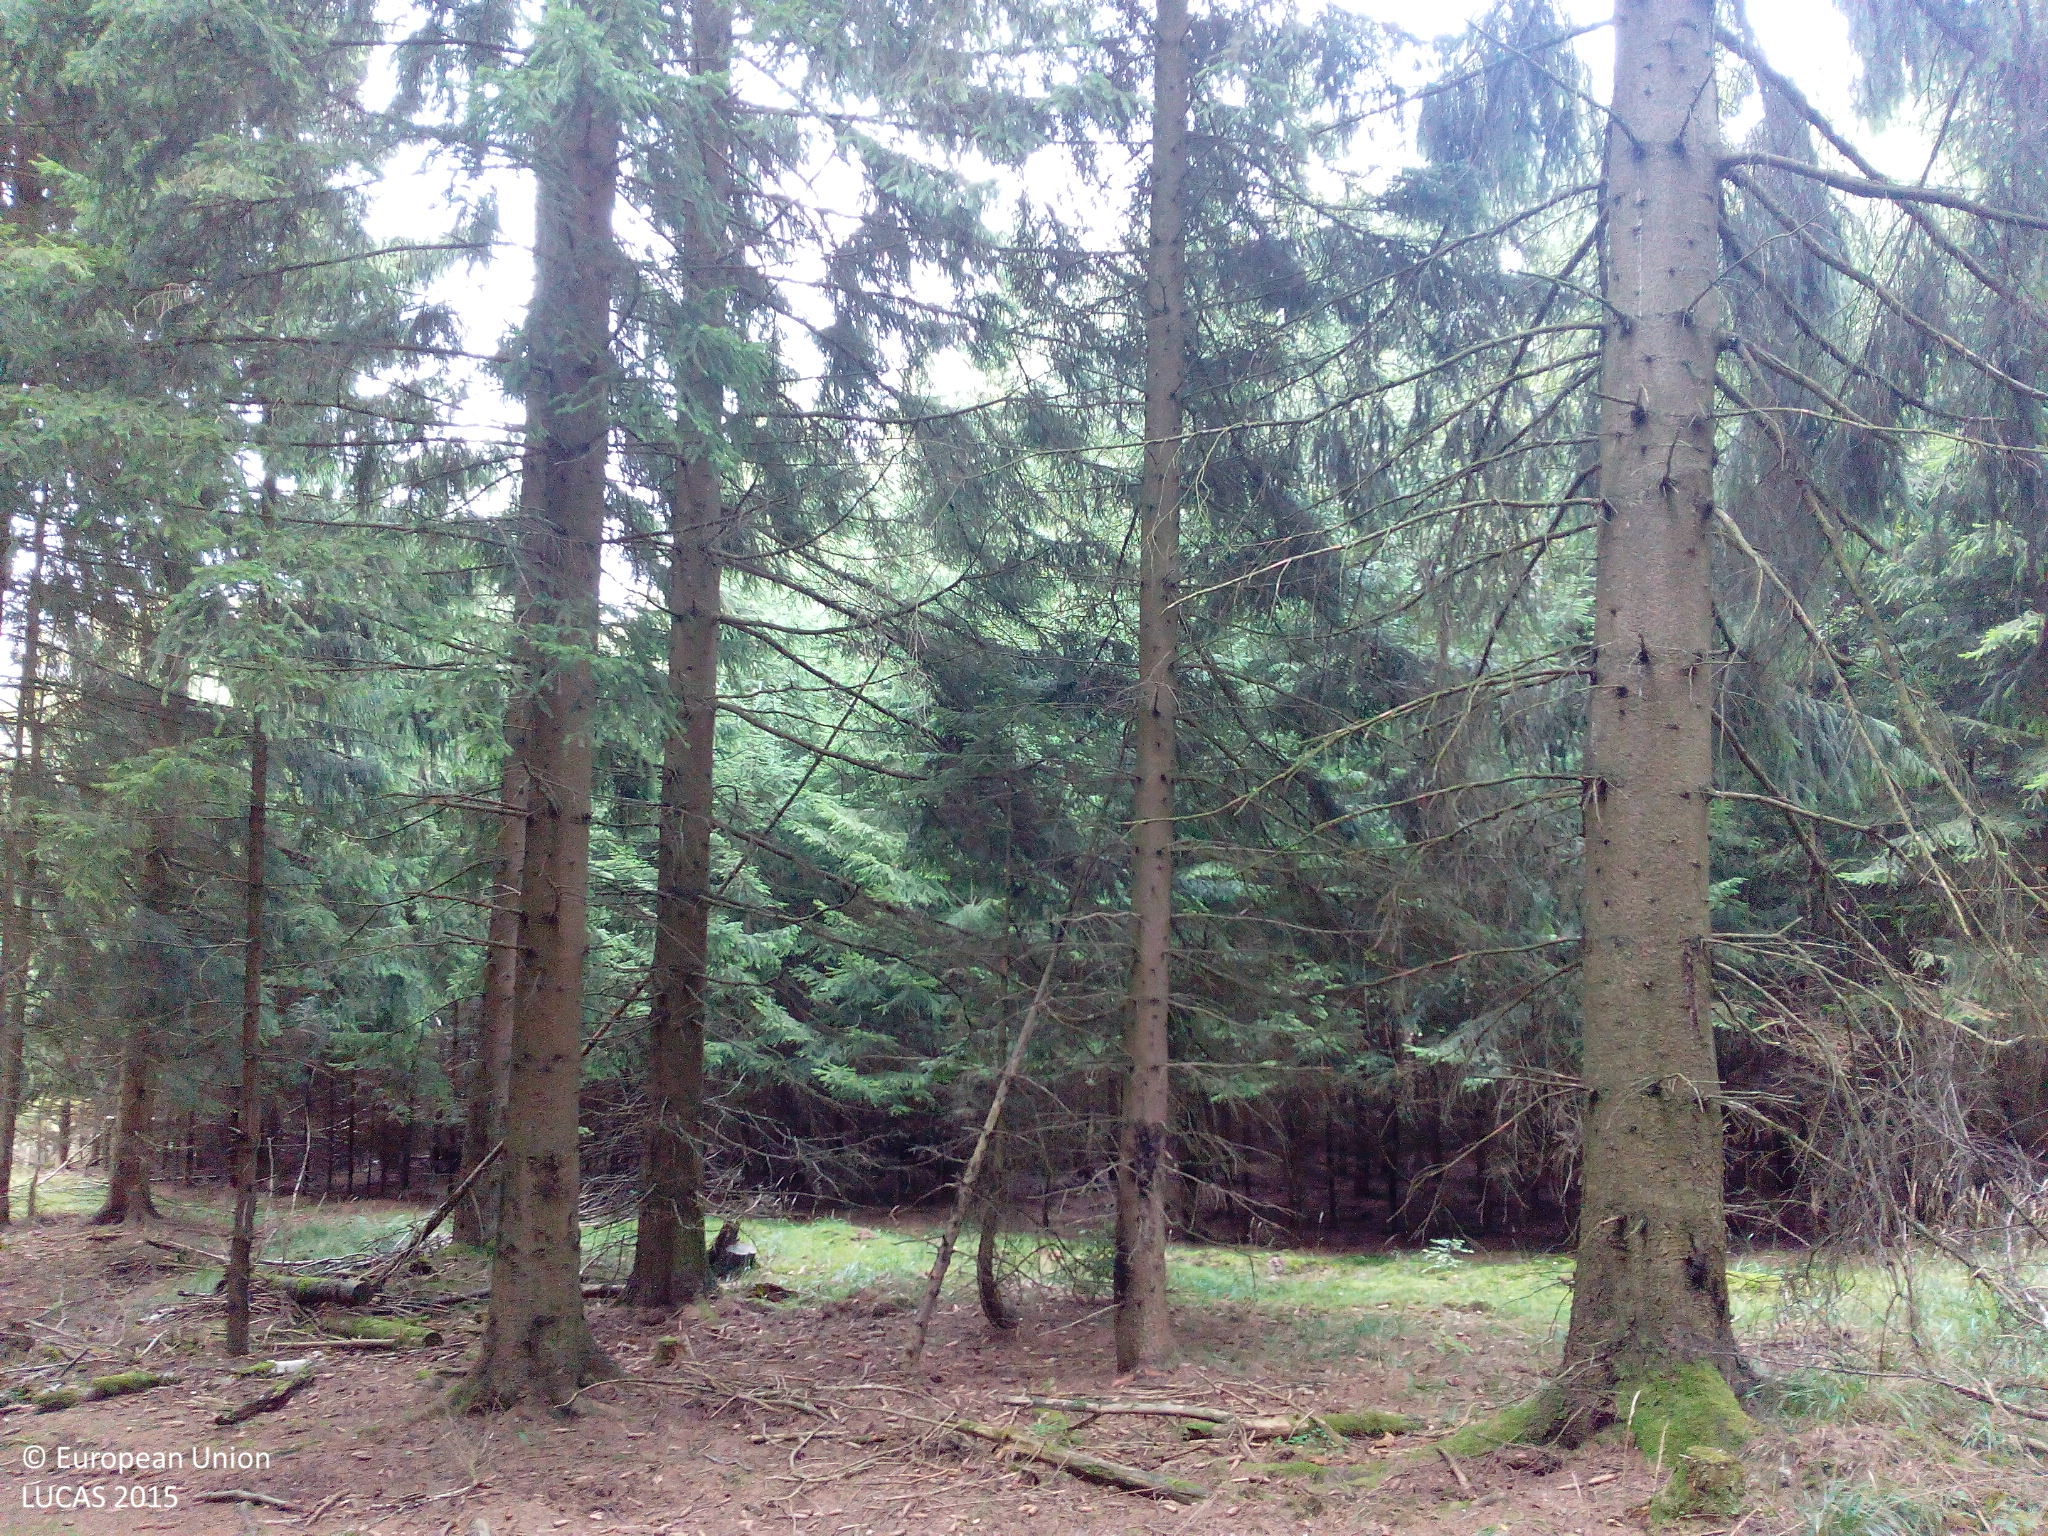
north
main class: Woodland
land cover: Spruce dominated coniferous woodland
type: hemiboreal forest and nemoral coniferous forest and mixed broadleaved-coniferous forest
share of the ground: > 75 %
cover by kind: coniferous forest trees 90 %, broadleaved forest trees 10 %
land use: Forestry
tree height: > 5 m
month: September
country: DE
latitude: 51.5821
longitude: 11.0243
